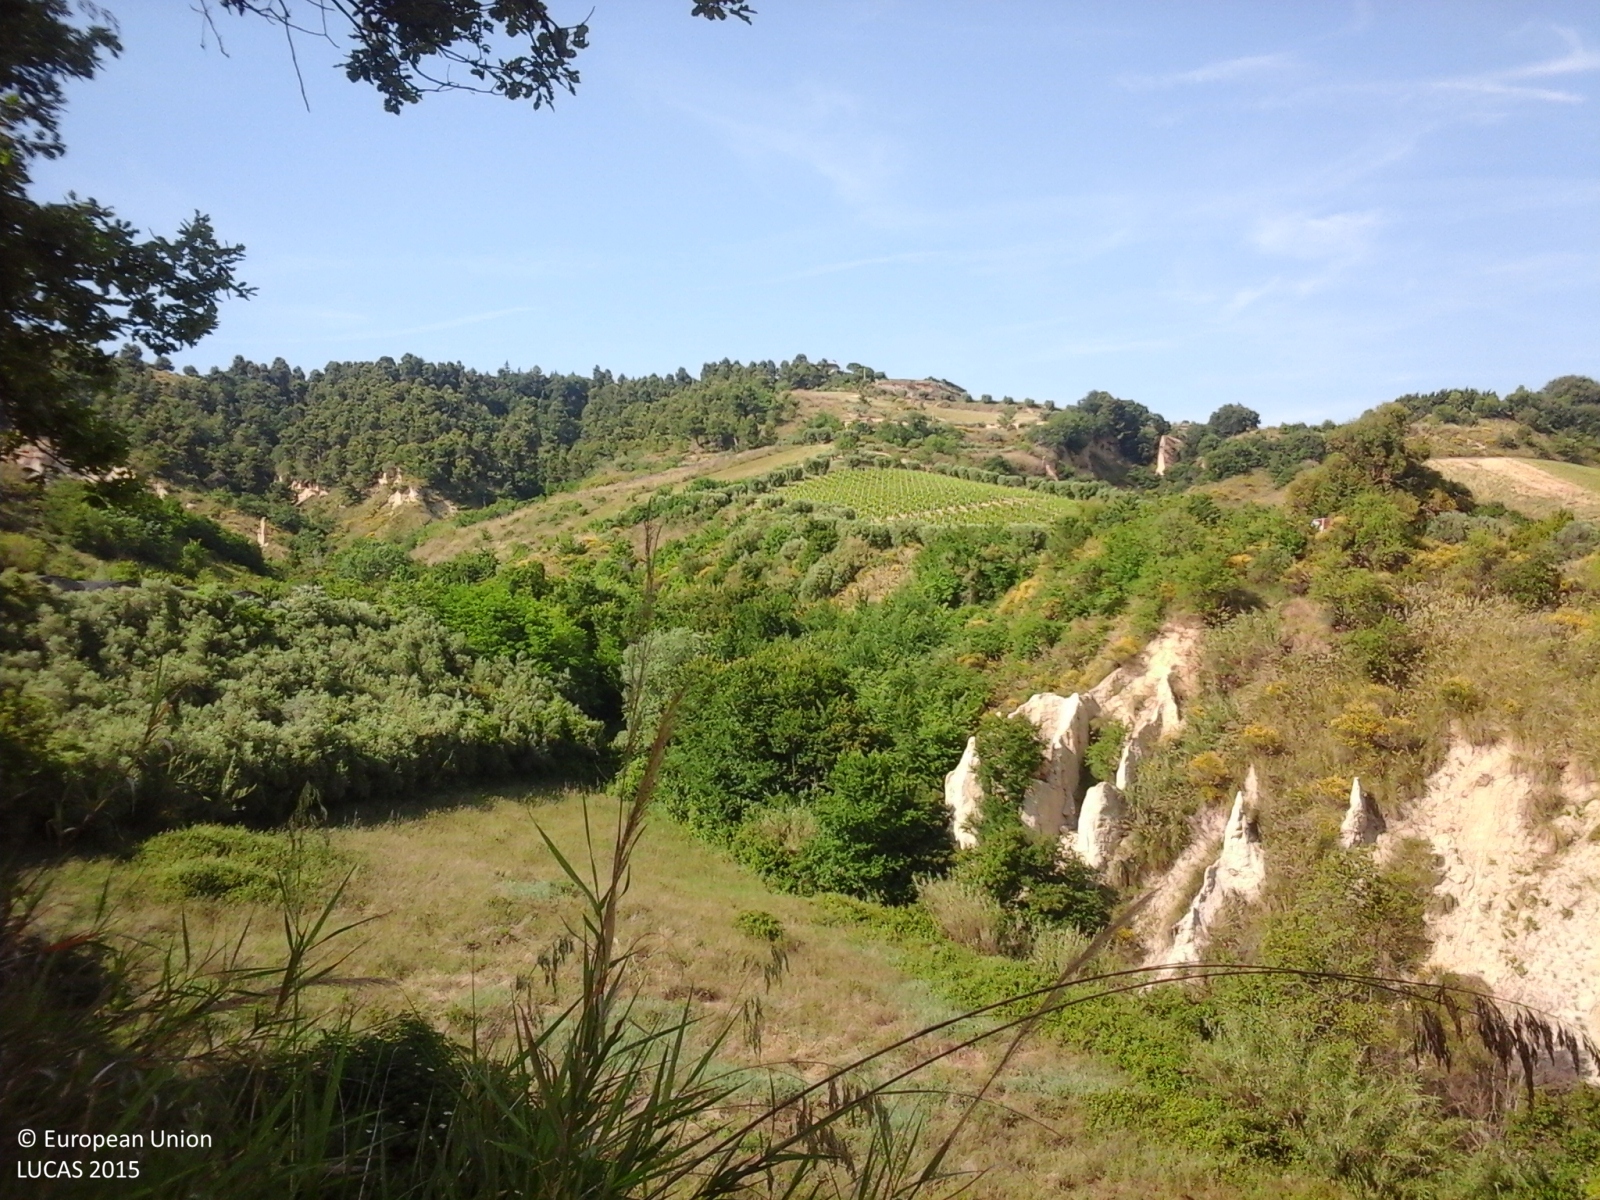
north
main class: Grassland
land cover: Grassland without tree/shrub cover
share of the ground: > 75 %
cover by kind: herbaceous plants 100 %
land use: Abandoned areas
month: May
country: IT
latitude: 42.9613
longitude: 13.8268
